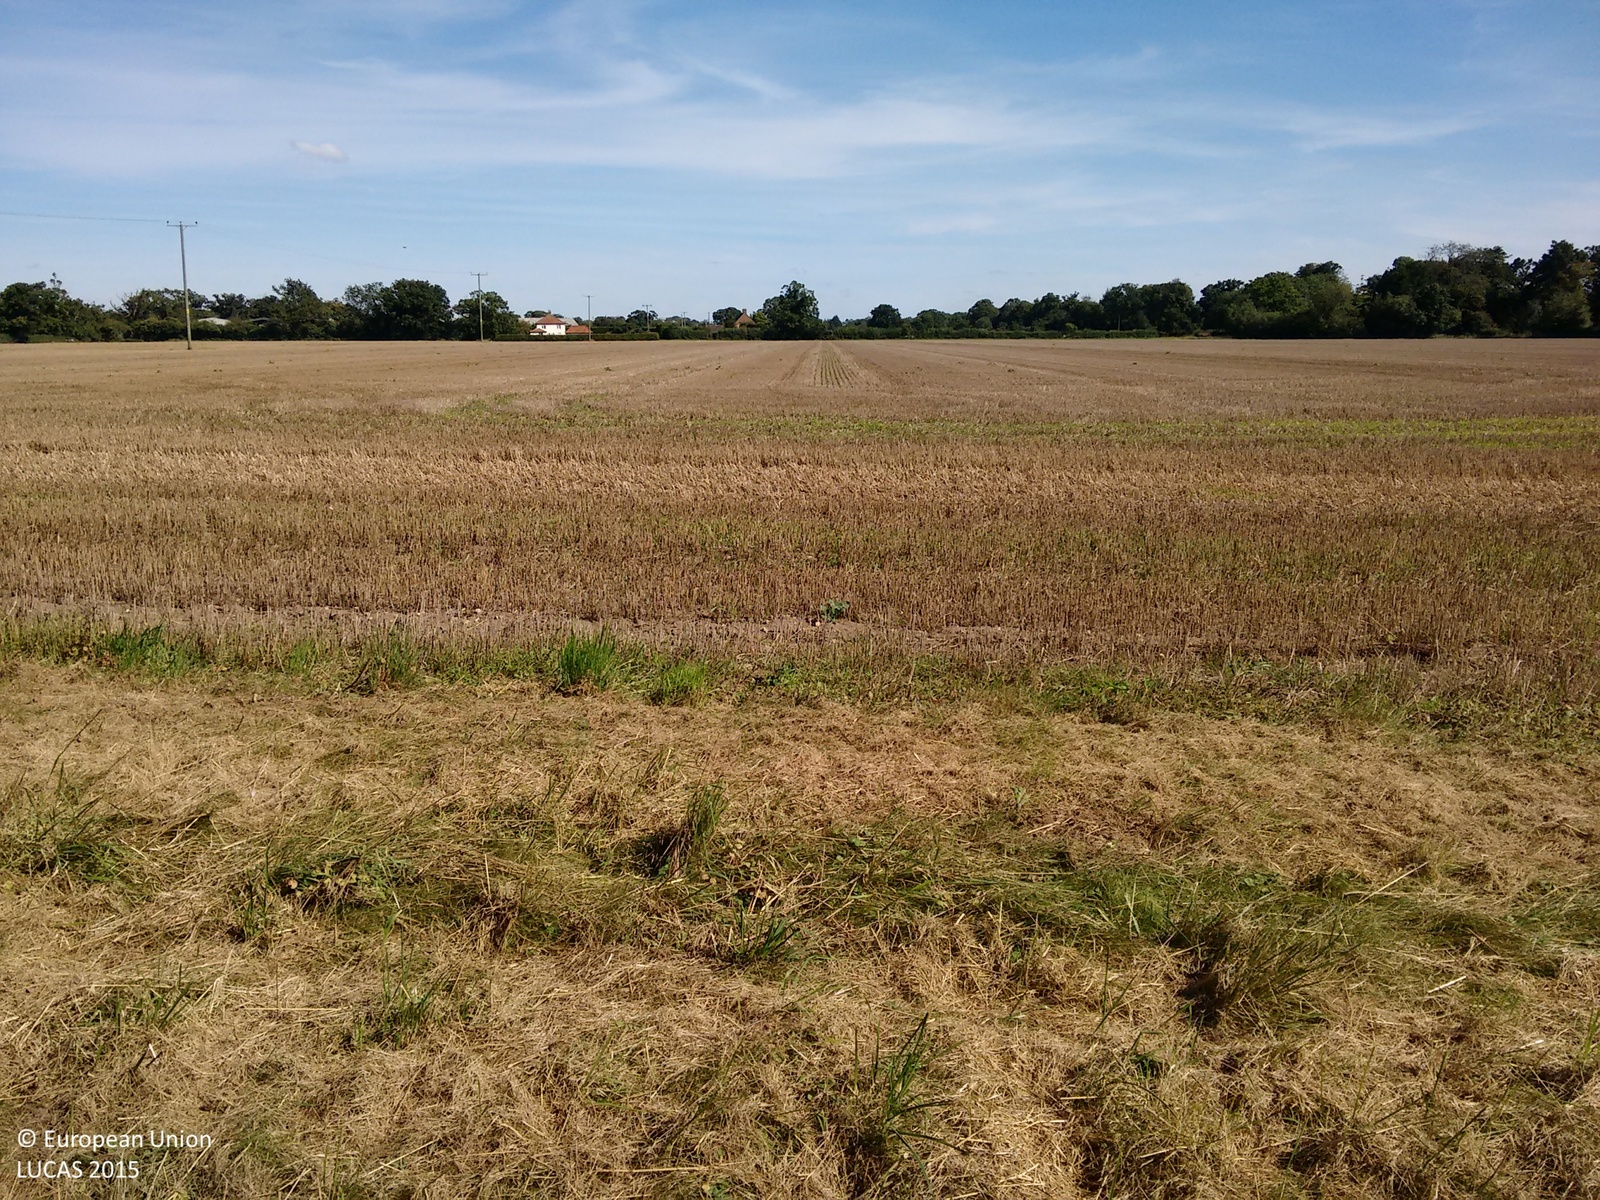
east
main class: Grassland
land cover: Grassland with sparse tree/shrub cover
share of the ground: > 75 %
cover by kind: herbaceous plants 95 %, broadleaved forest trees 5 %
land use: Amenities, museums, leisure
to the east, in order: Grassland with sparse tree/shrub cover; Fences; Tracks; Grass margins; Managed hedges; Grass margins; Common wheat
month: September
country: GB
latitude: 52.4946
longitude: 0.8585
